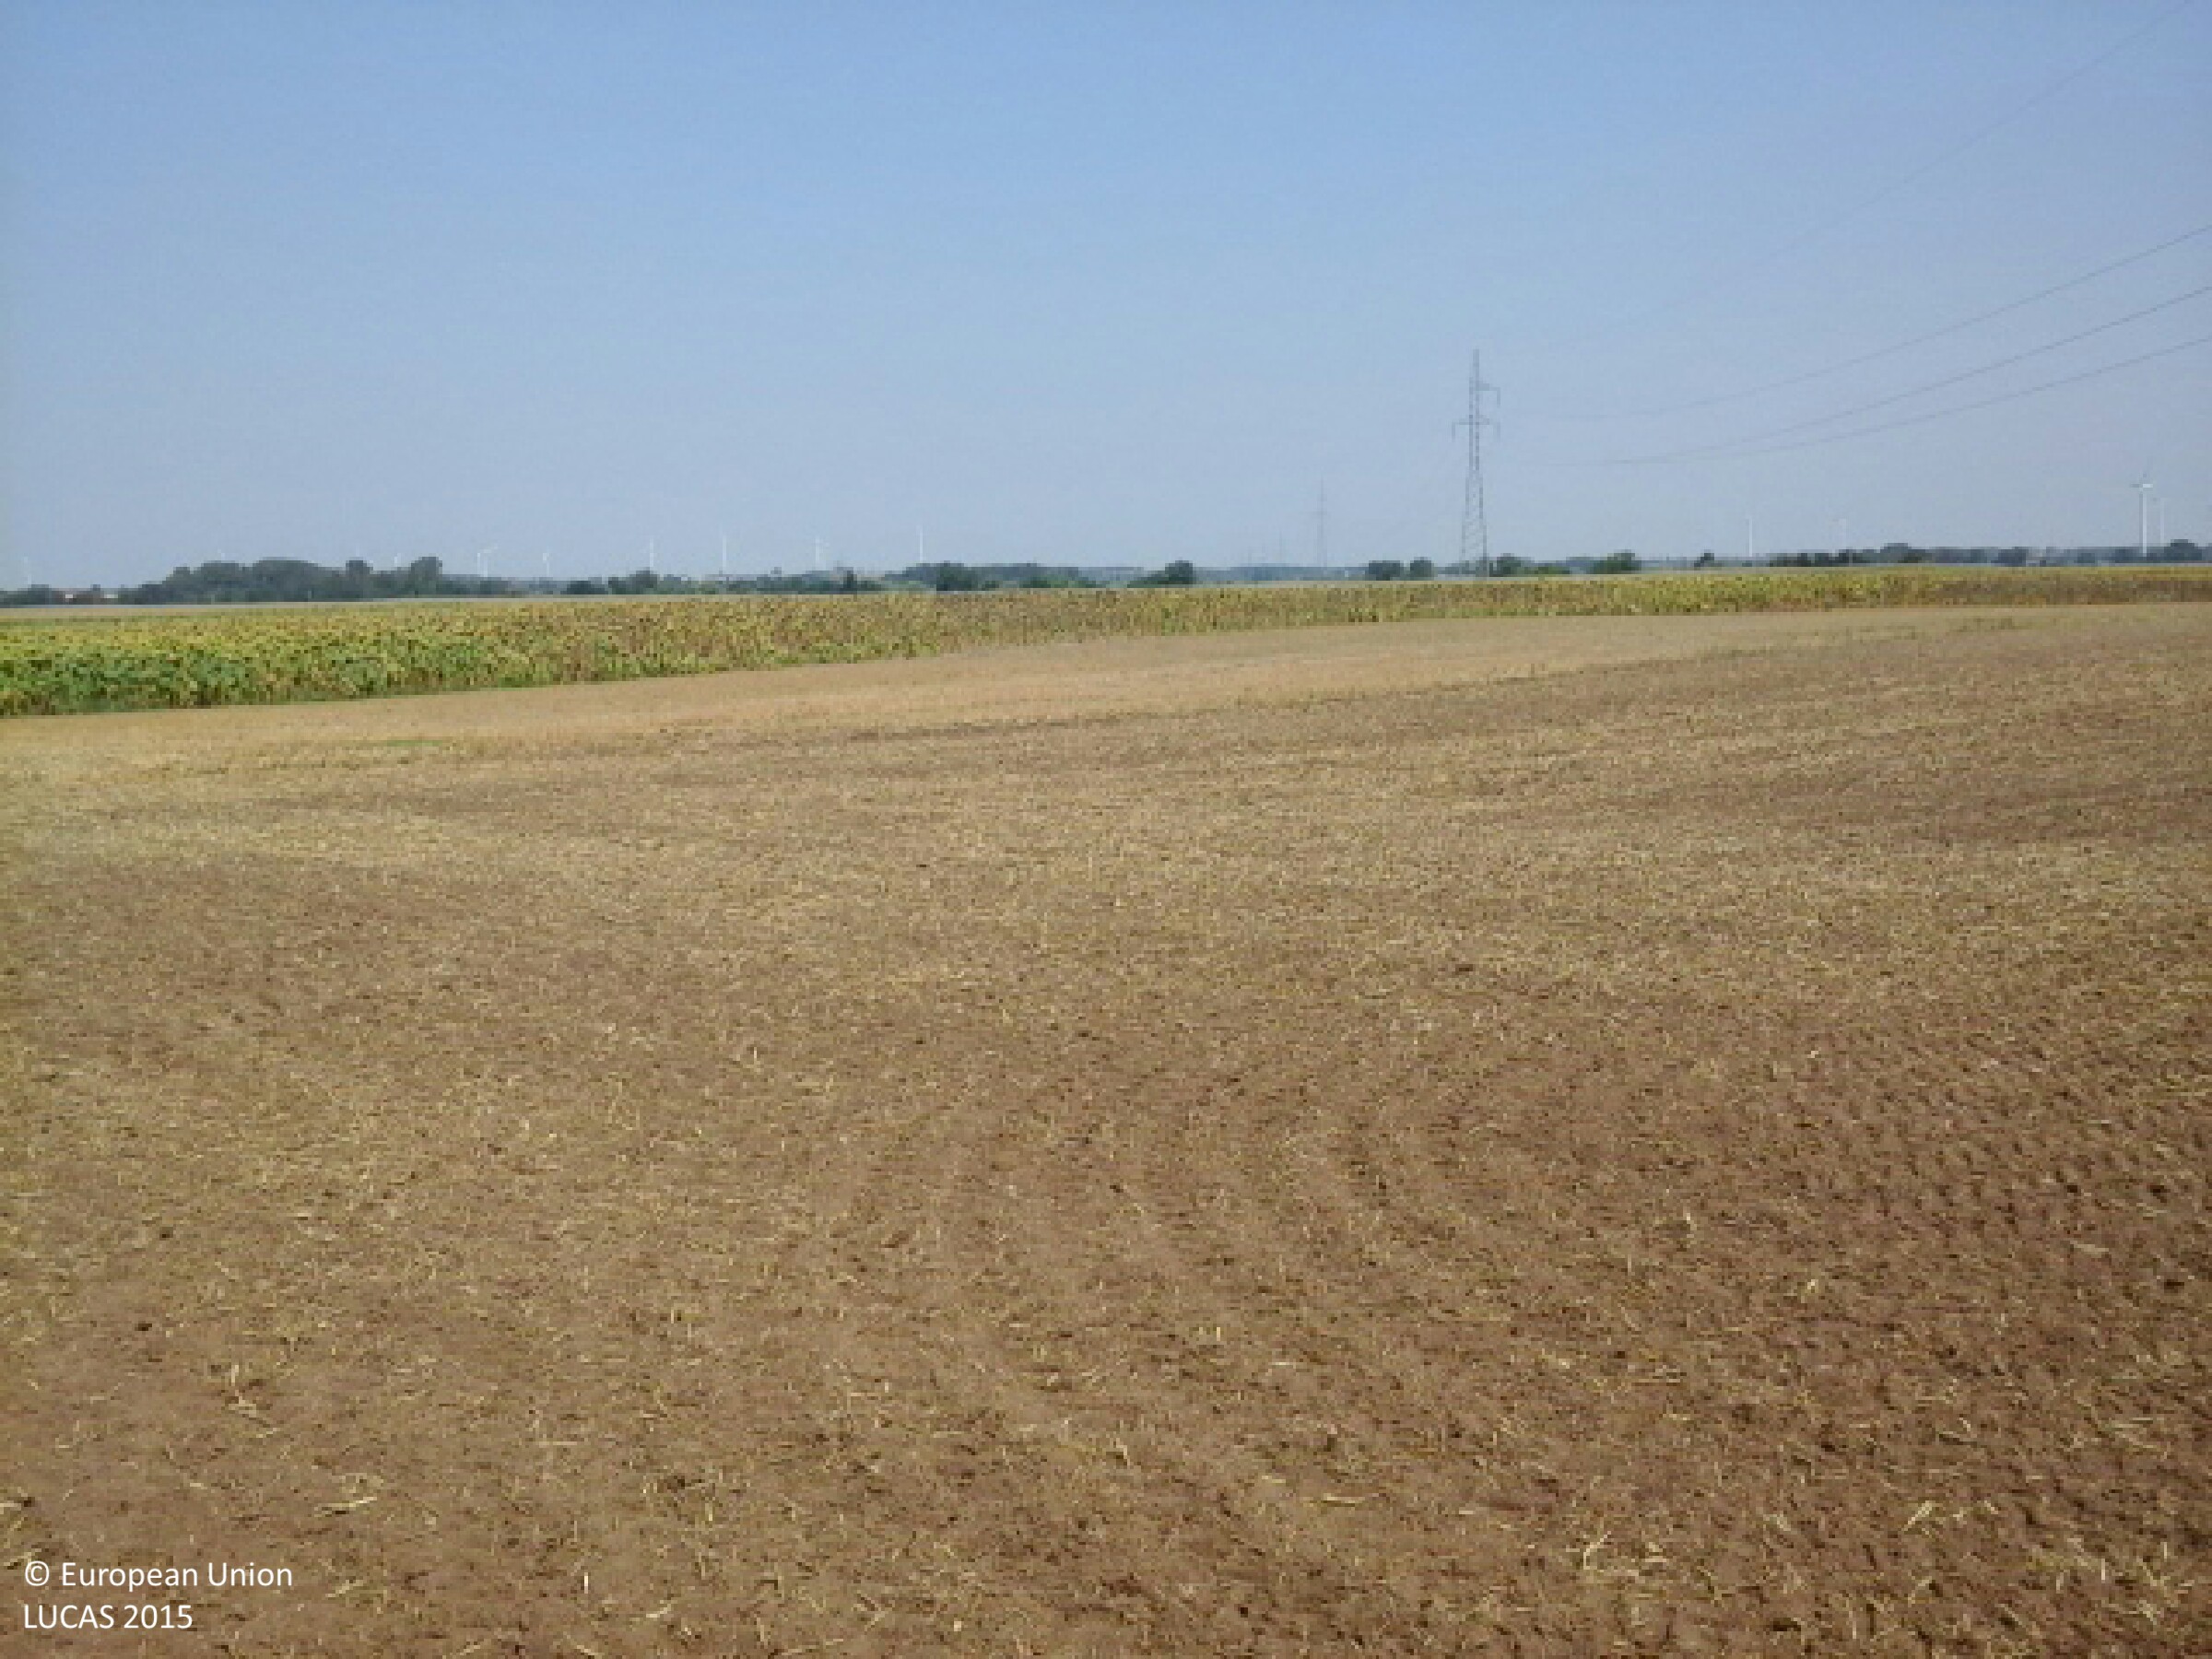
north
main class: Cropland
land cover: Common wheat
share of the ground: < 10 %
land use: Agriculture (excluding fallow land and kitchen gardens)
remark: Harvested field
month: August
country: HU
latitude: 47.6186
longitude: 18.0878
